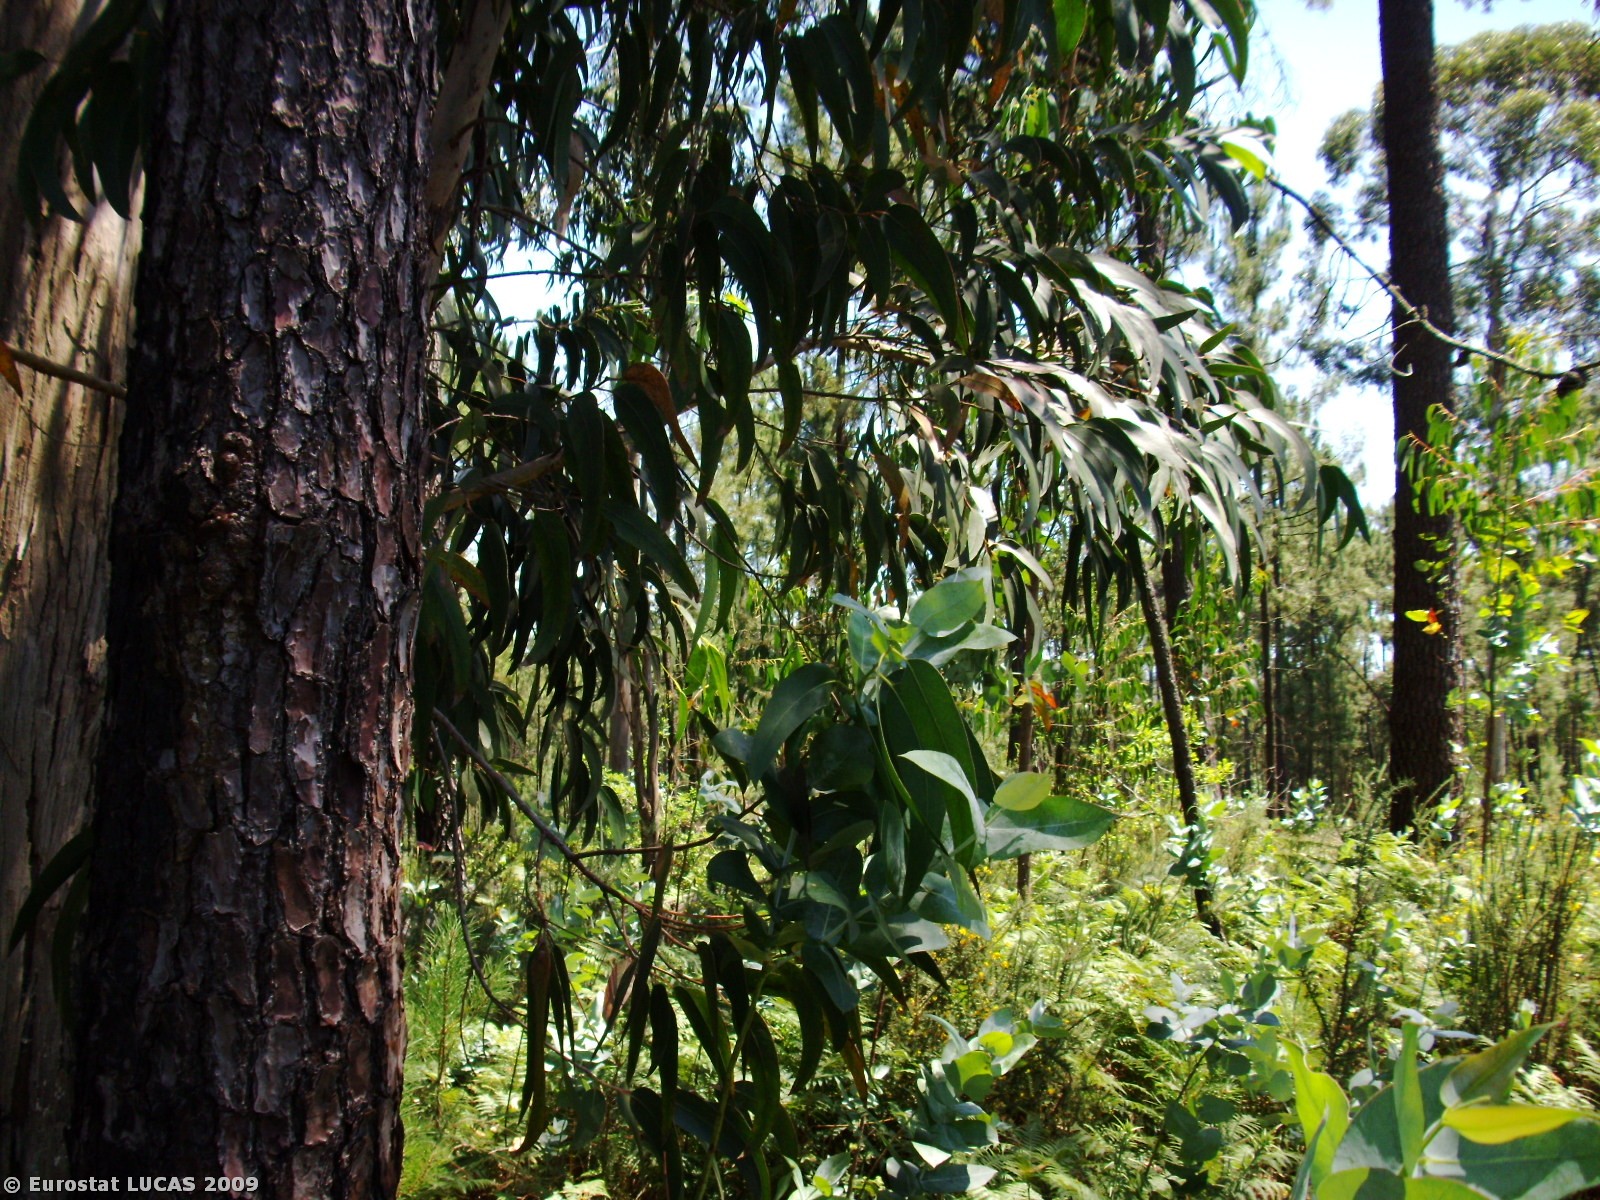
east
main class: Woodland
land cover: Mixed woodland
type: hemiboreal forest and nemoral coniferous forest and mixed broadleaved-coniferous forest
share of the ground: > 75 %
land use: Forestry
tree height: > 5 m
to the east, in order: Mixed woodland; Paved roads, cycling and walking lanes; Electric lines; Spontaneously vegetated surfaces; Artificial constructions in urban areas; Spontaneously vegetated surfaces
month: July
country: PT
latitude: 41.6183
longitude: -8.7798
